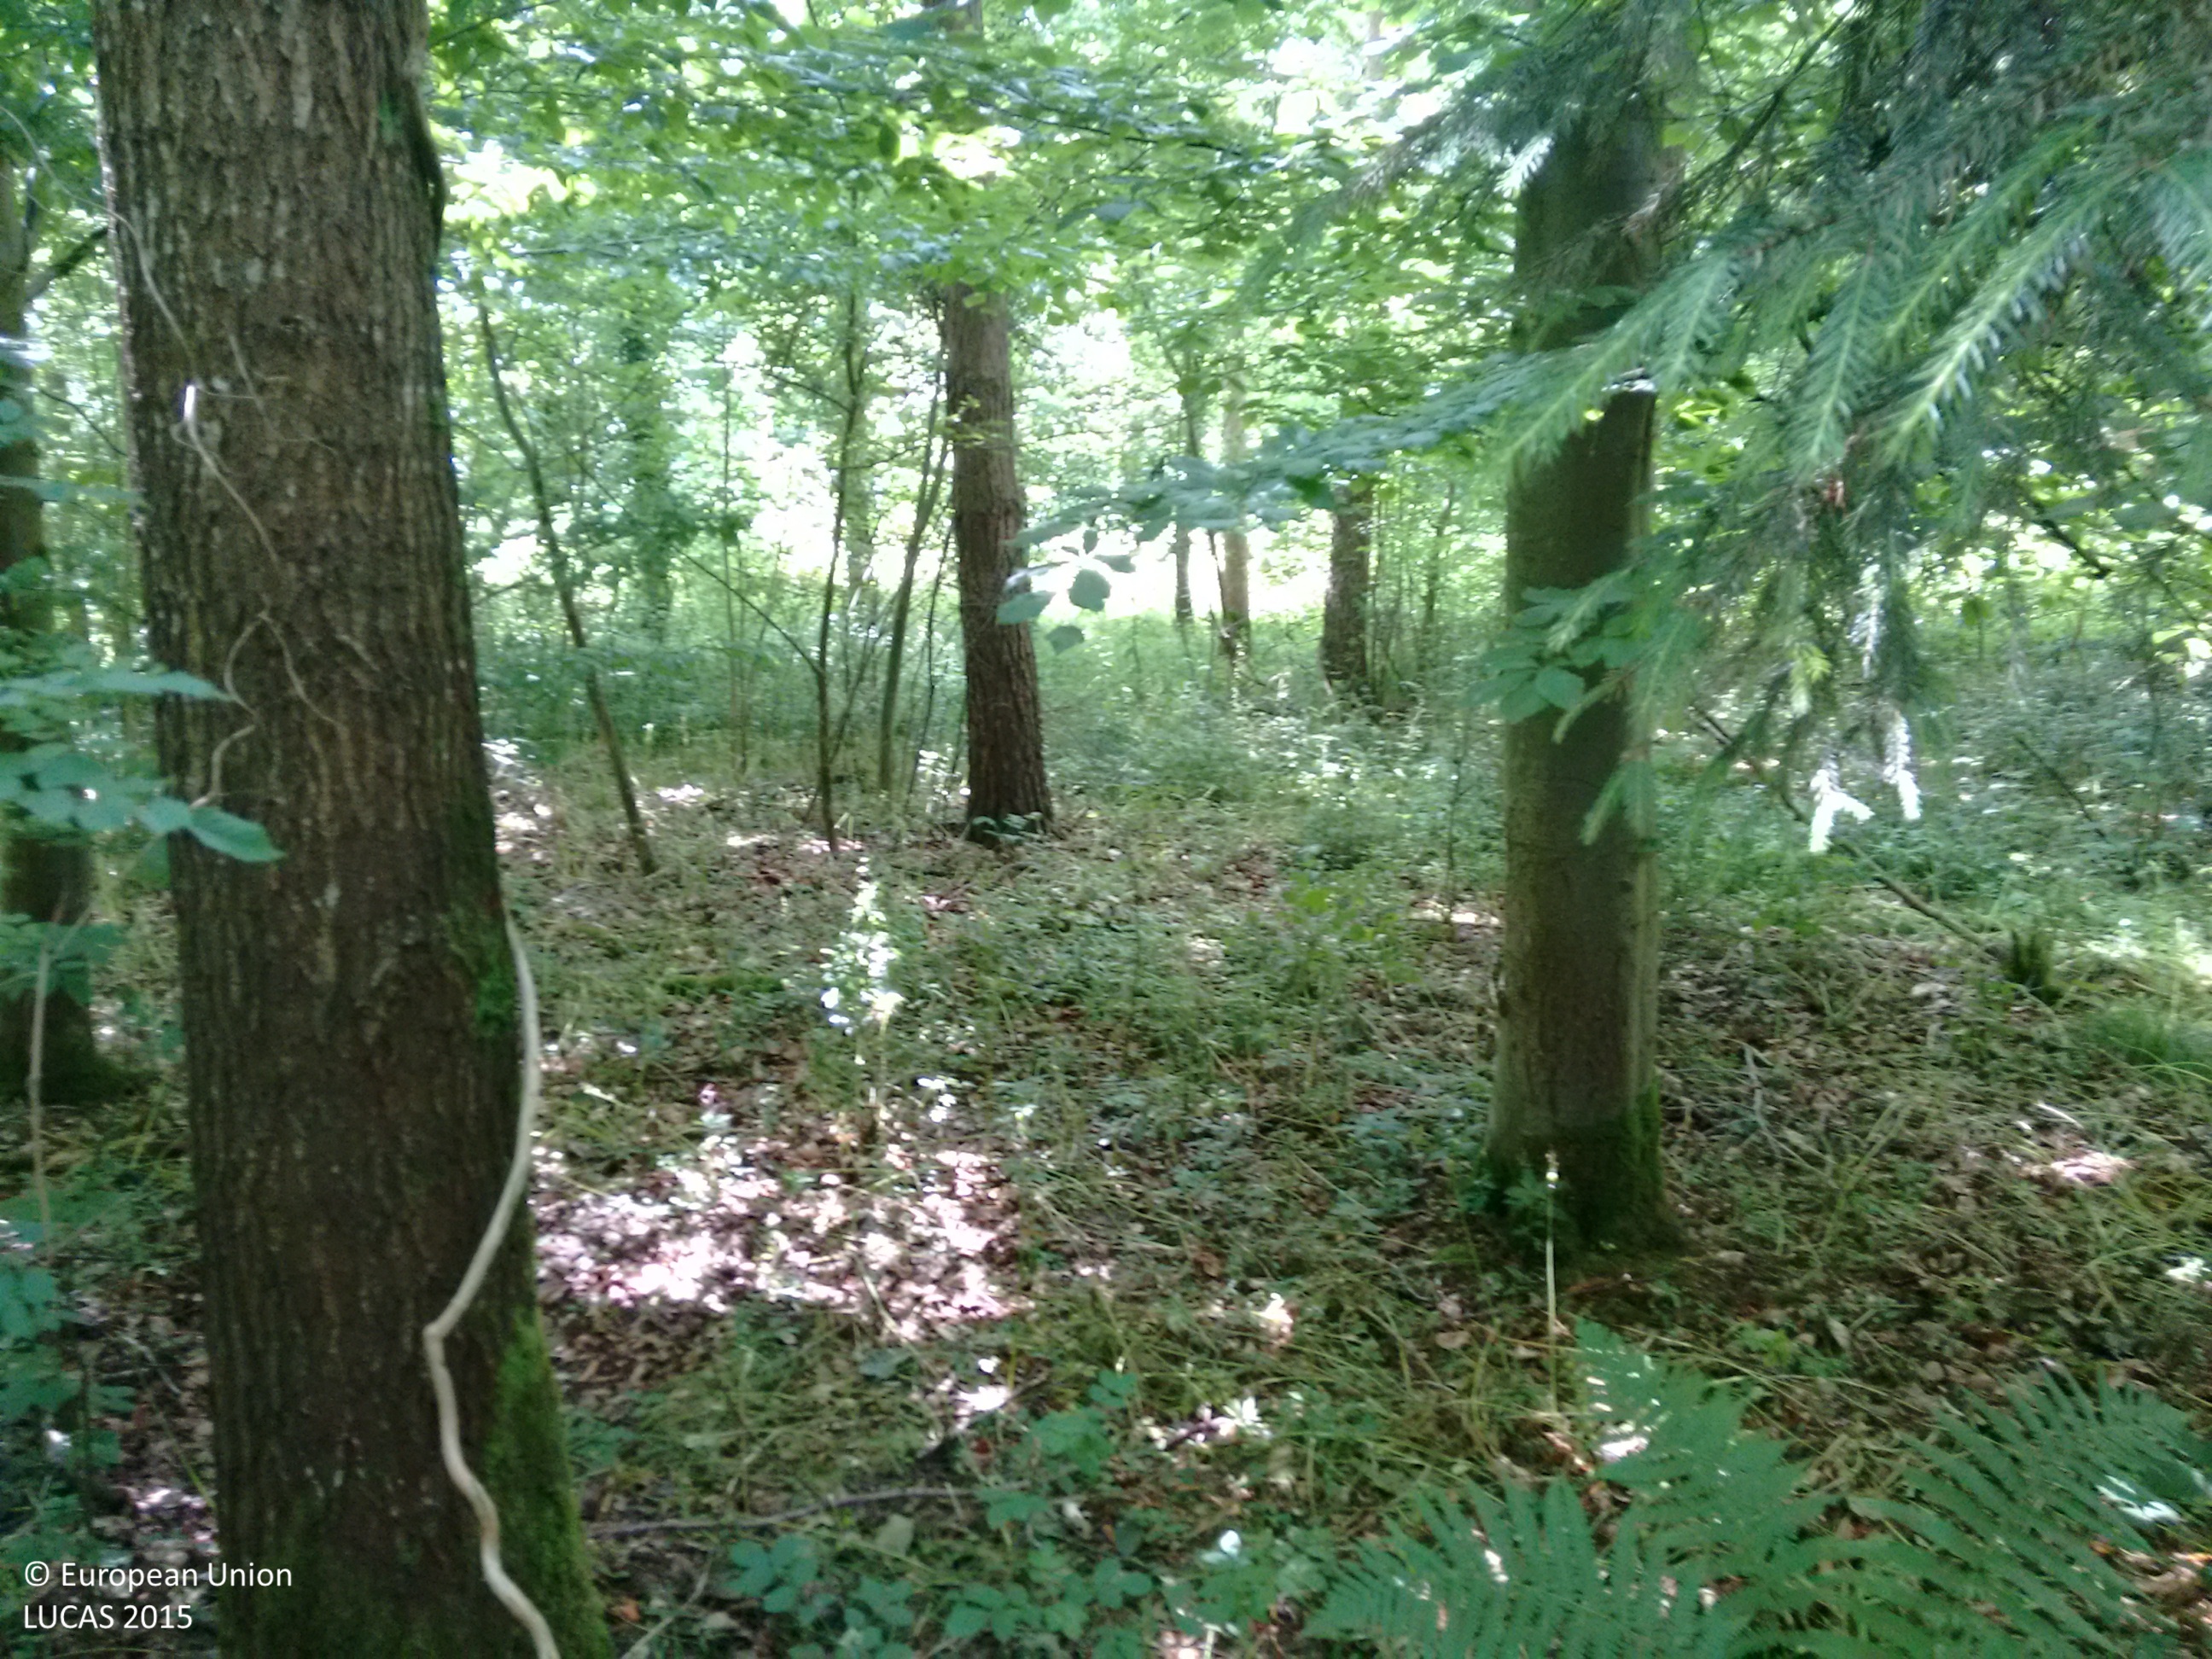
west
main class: Woodland
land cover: Broadleaved woodland
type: mesophytic deciduous forest
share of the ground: > 75 %
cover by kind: broadleaved forest trees 80 %, coniferous forest trees 20 %
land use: Forestry
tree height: > 5 m
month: June
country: GB
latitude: 51.3429
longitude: -2.2215
